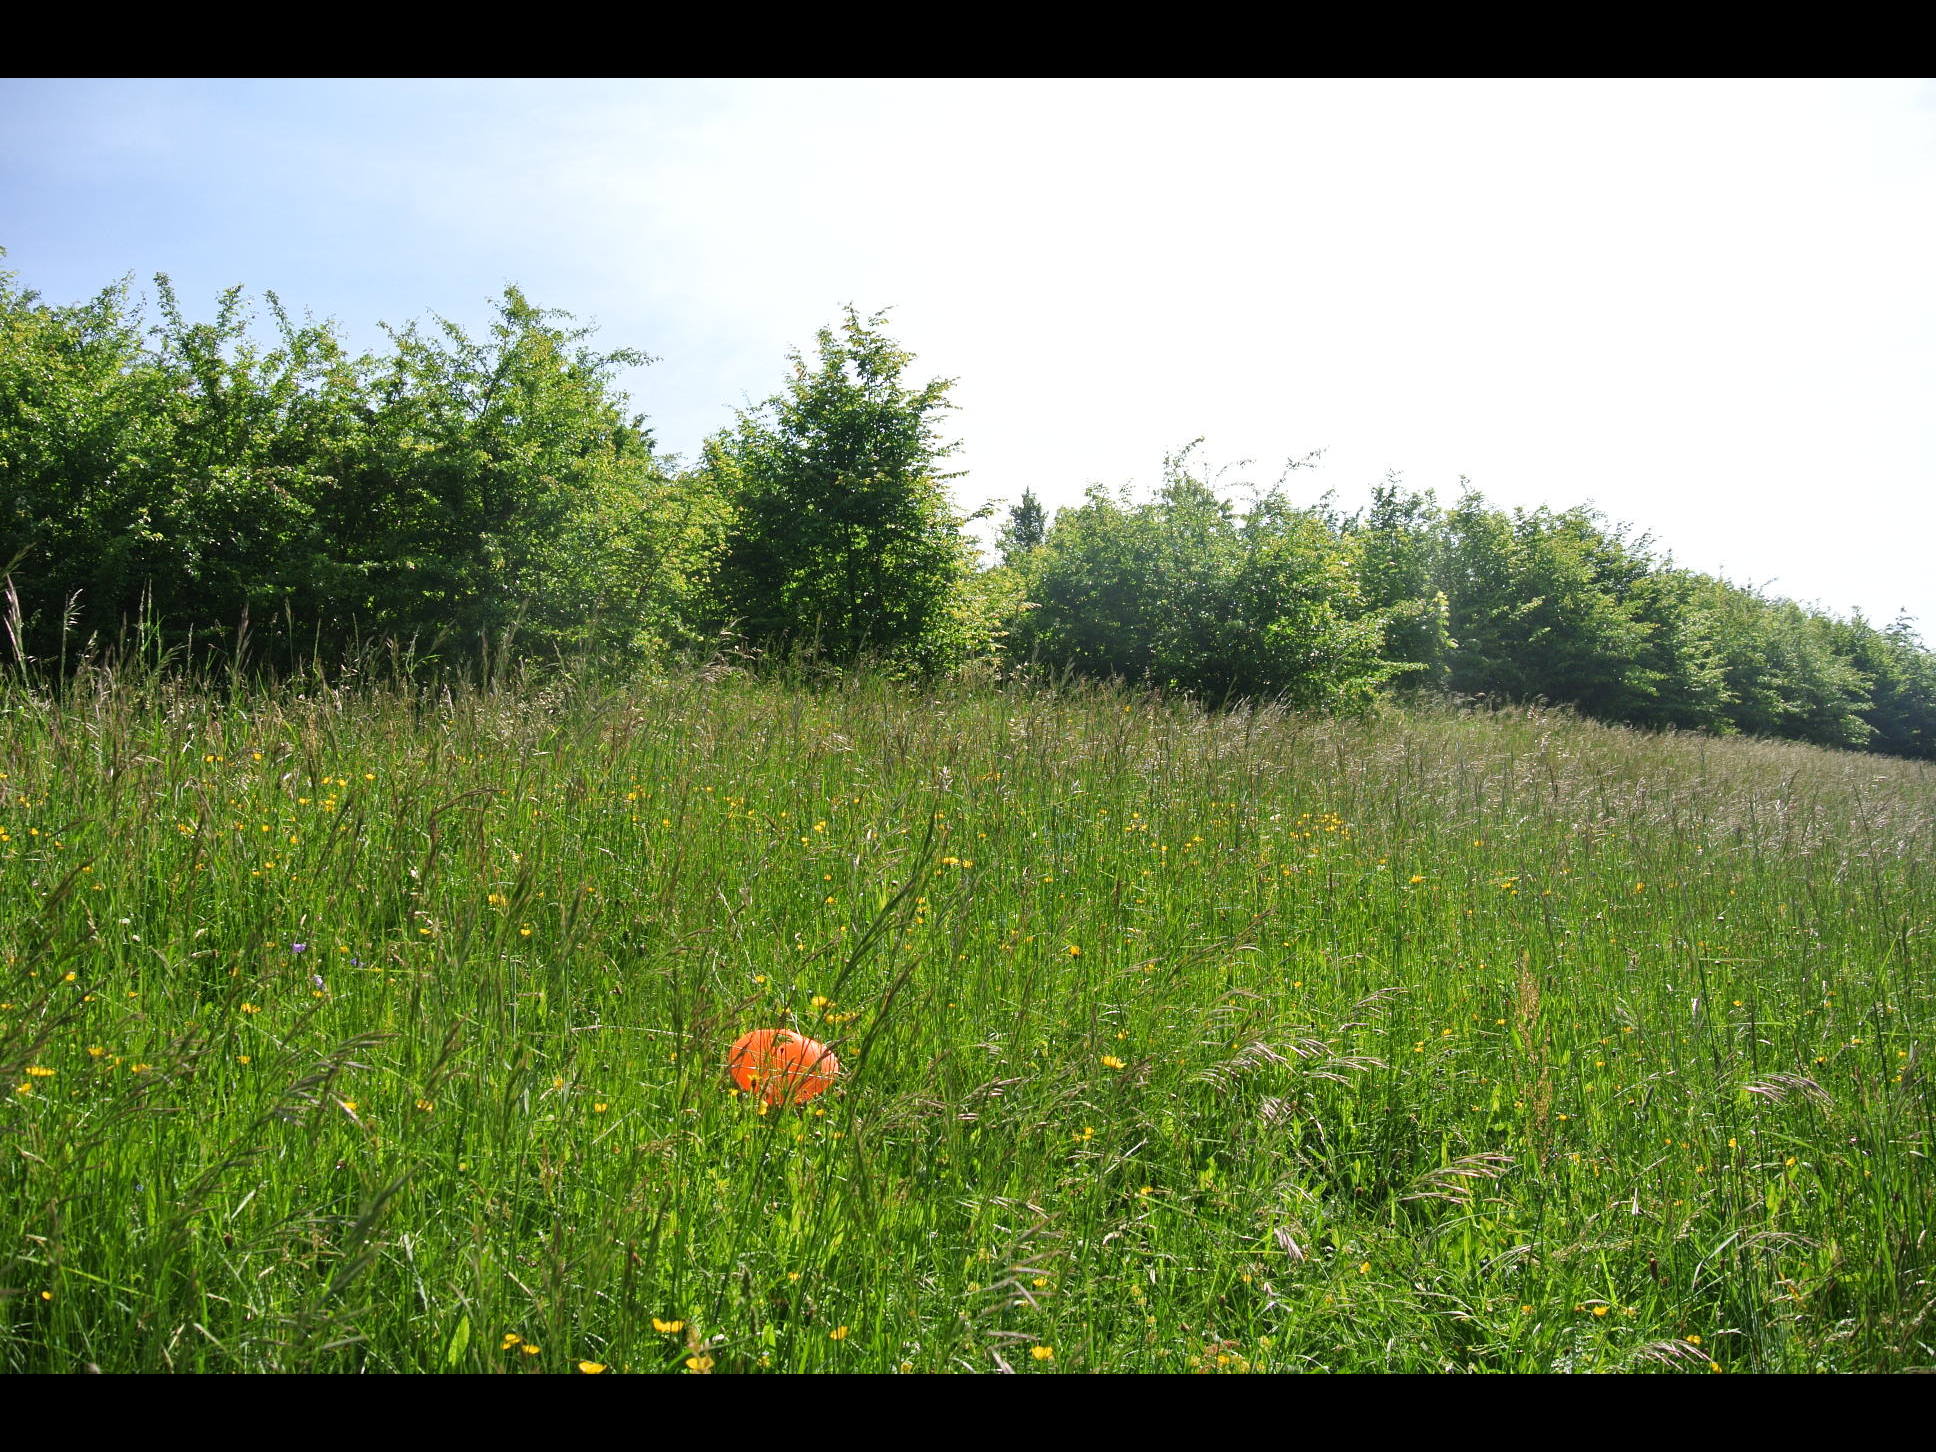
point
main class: Grassland
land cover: Grassland without tree/shrub cover
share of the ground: > 75 %
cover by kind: herbaceous plants 100 %
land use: Agriculture (excluding fallow land and kitchen gardens)
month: May
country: AT
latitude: 48.0328
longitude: 15.8367
